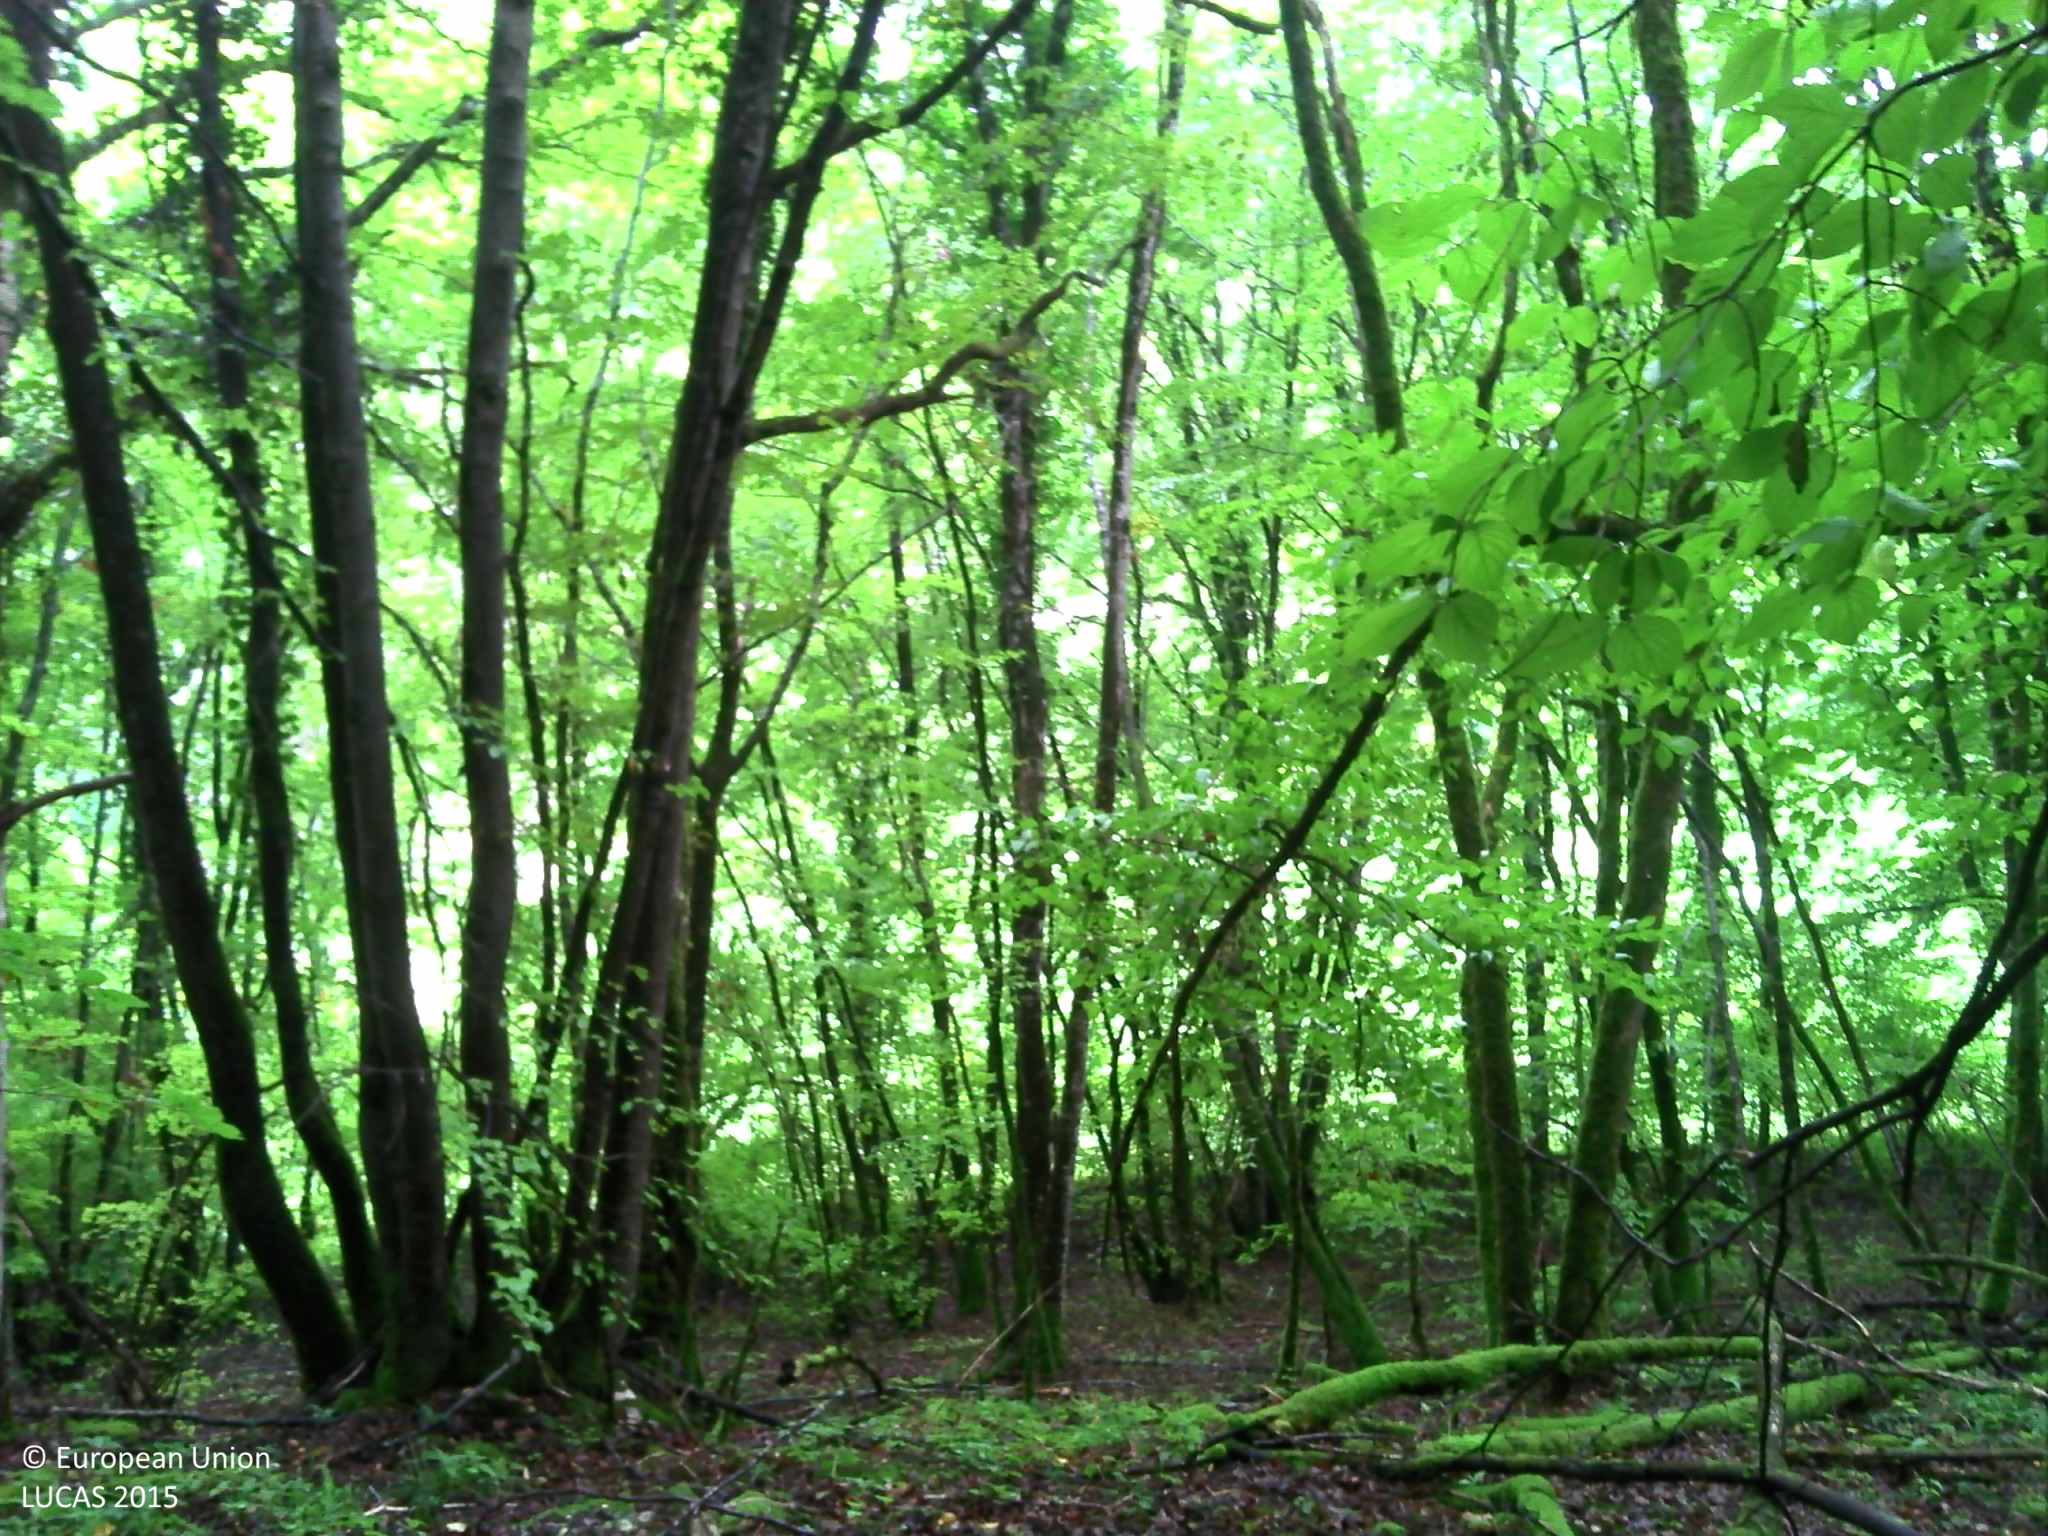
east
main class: Woodland
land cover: Broadleaved woodland
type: mesophytic deciduous forest
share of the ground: > 75 %
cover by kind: broadleaved forest trees 75 %, herbaceous plants 15 %, shrubs 10 %
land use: Forestry
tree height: > 5 m
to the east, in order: Broadleaved woodland; Fences; Grassland without tree/shrub cover; Abandoned hedges; Rivers and streams; Abandoned hedges; Grassland without tree/shrub cover; Electric lines; Grassland without tree/shrub cover; Dry stone walls; Grass margins; Paved roads, cycling and walking lanes; Grass margins; Electric lines; Fences; Grassland without tree/shrub cover; Broadleaved woodland; Grassland without tree/shrub cover; Broadleaved woodland
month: September
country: FR
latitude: 47.1408
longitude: 4.7128
